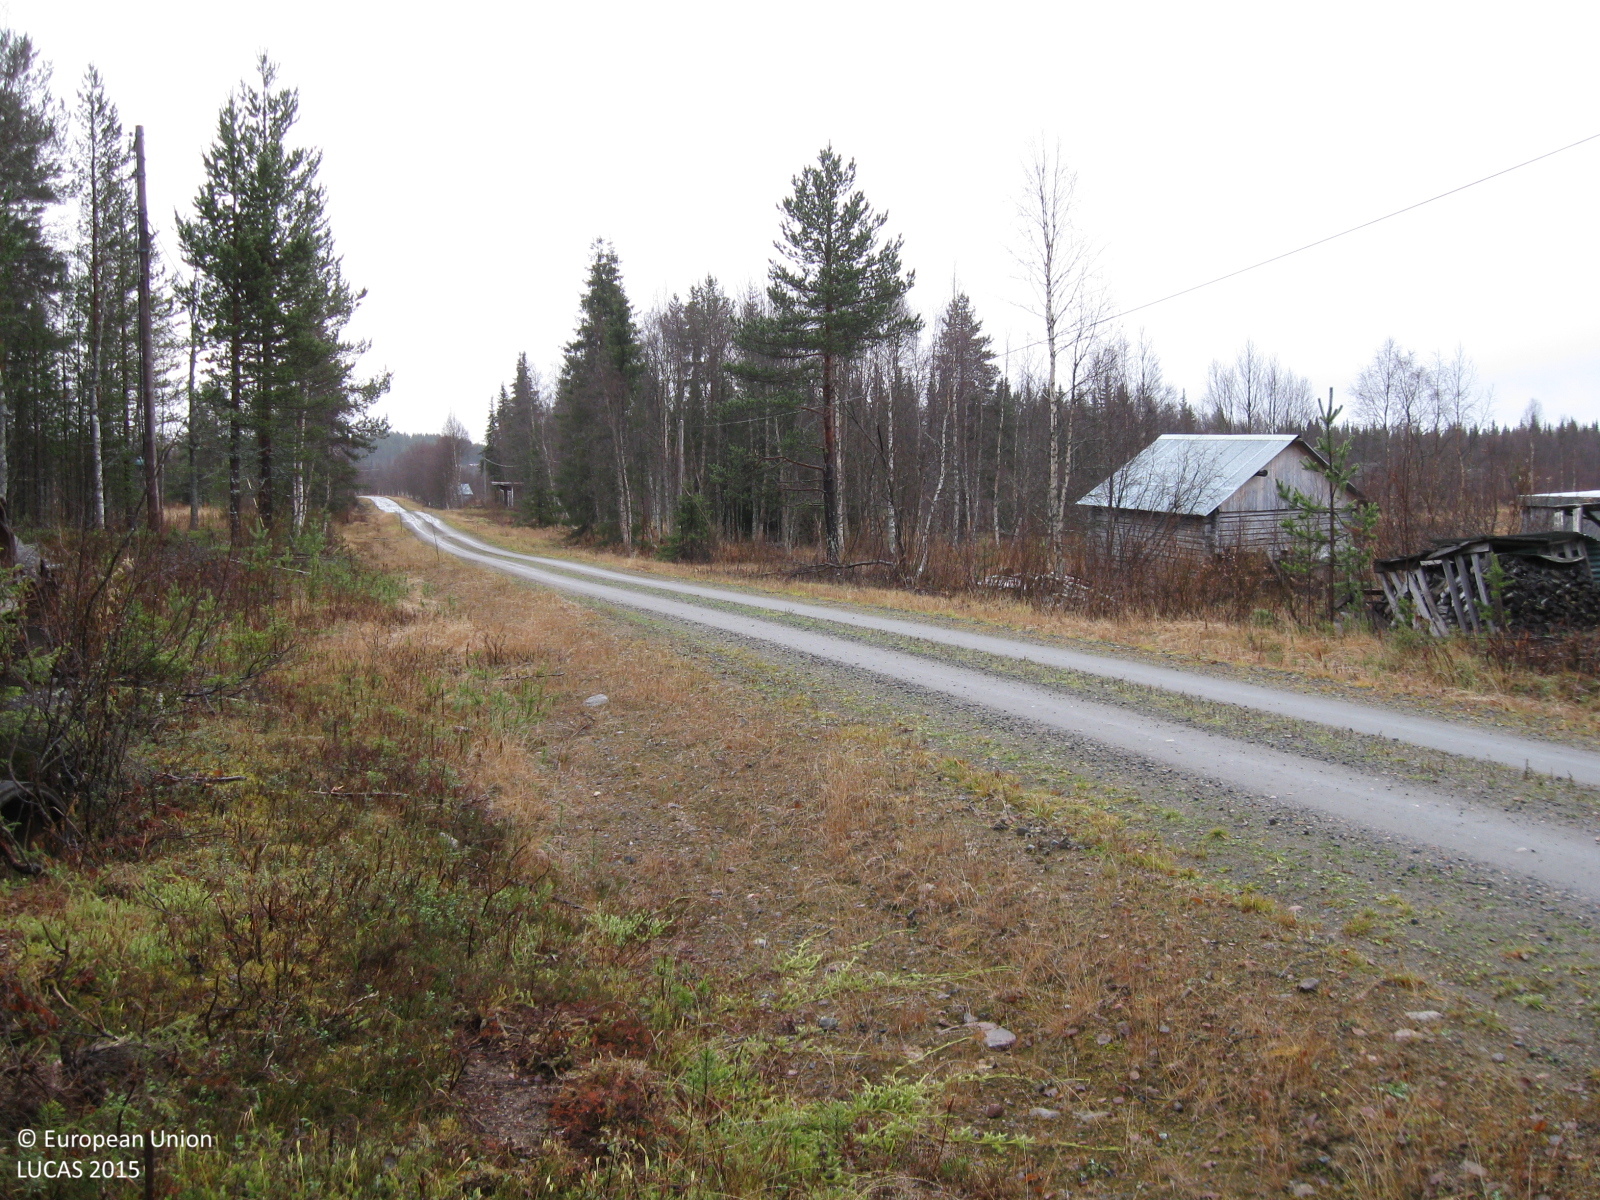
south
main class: Woodland
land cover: Spruce dominated mixed woodland
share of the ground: 25 - 50 %
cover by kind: shrubs 30 %, coniferous forest trees 25 %, broadleaved forest trees 20 %, herbaceous plants 10 %, lichens and mosses 10 %, unconsolidated bare surface 5 %
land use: Road transport
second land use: Forestry
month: October
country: SE
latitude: 66.7755
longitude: 21.0230
